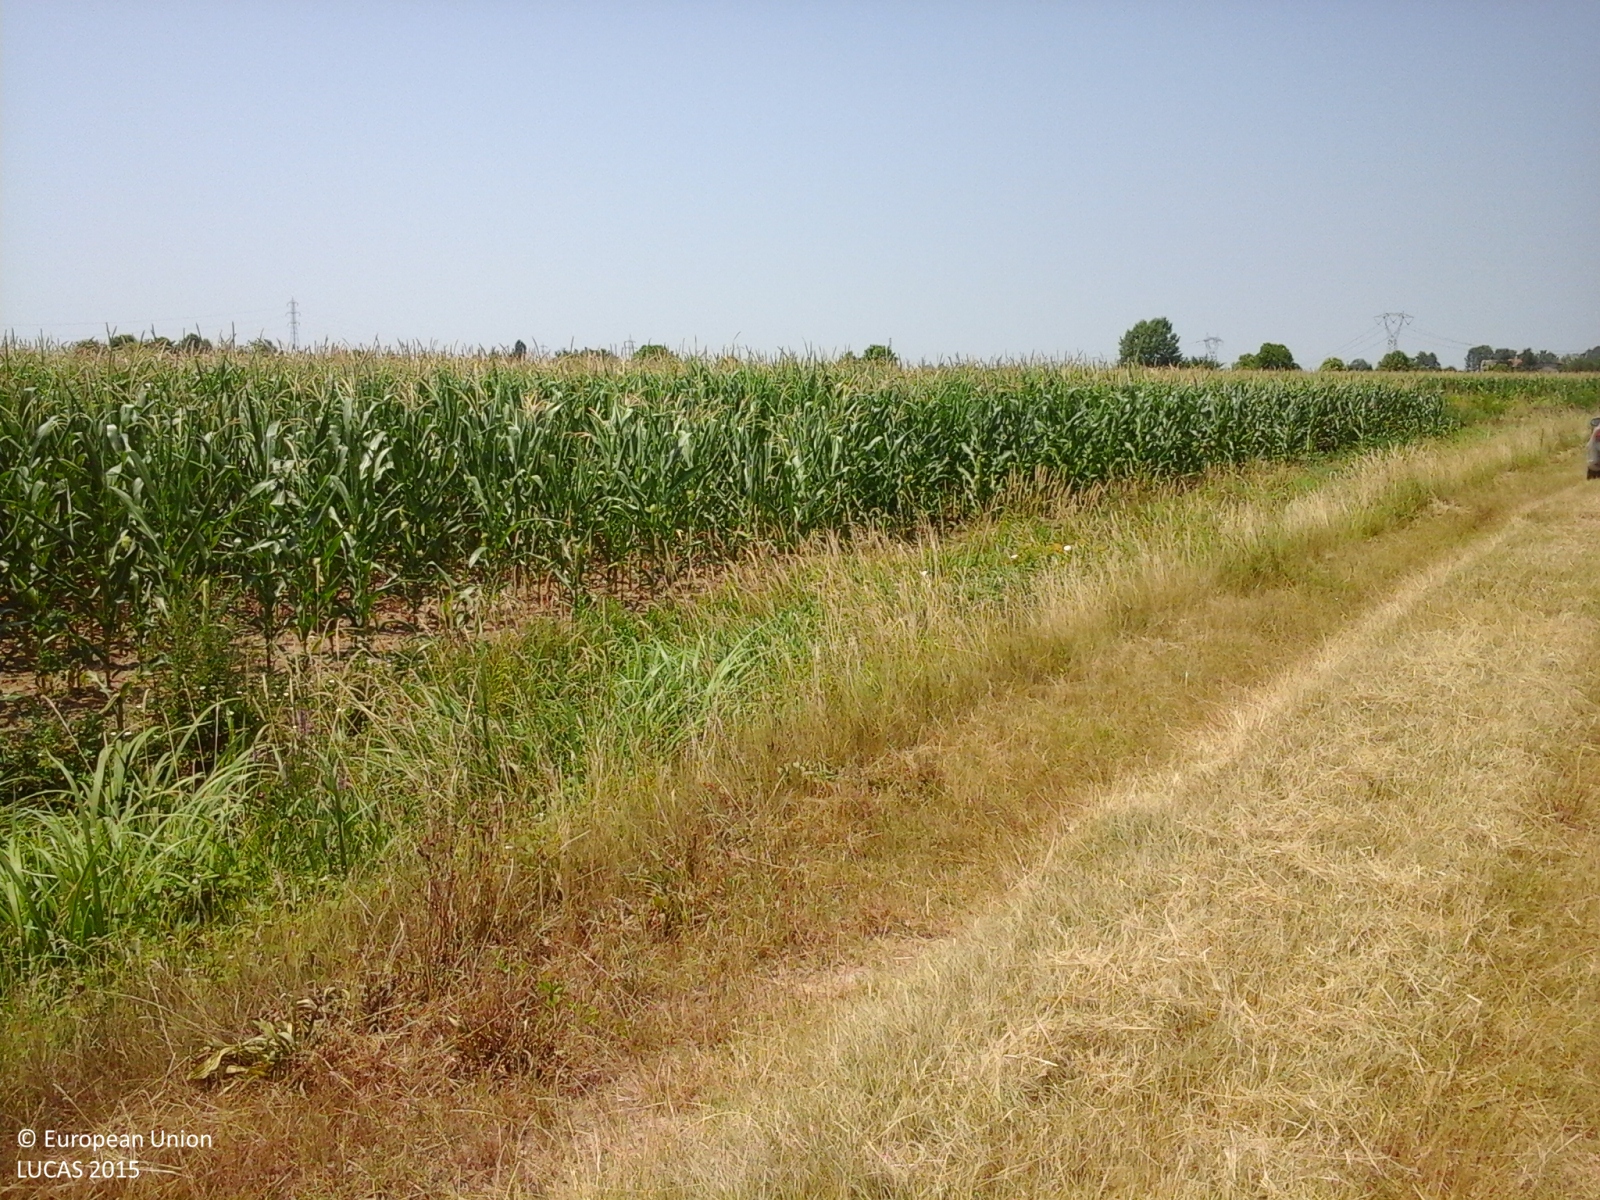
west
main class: Cropland
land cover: Maize
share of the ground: > 75 %
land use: Agriculture (excluding fallow land and kitchen gardens)
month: July
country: IT
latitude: 45.3021
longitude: 10.9293
